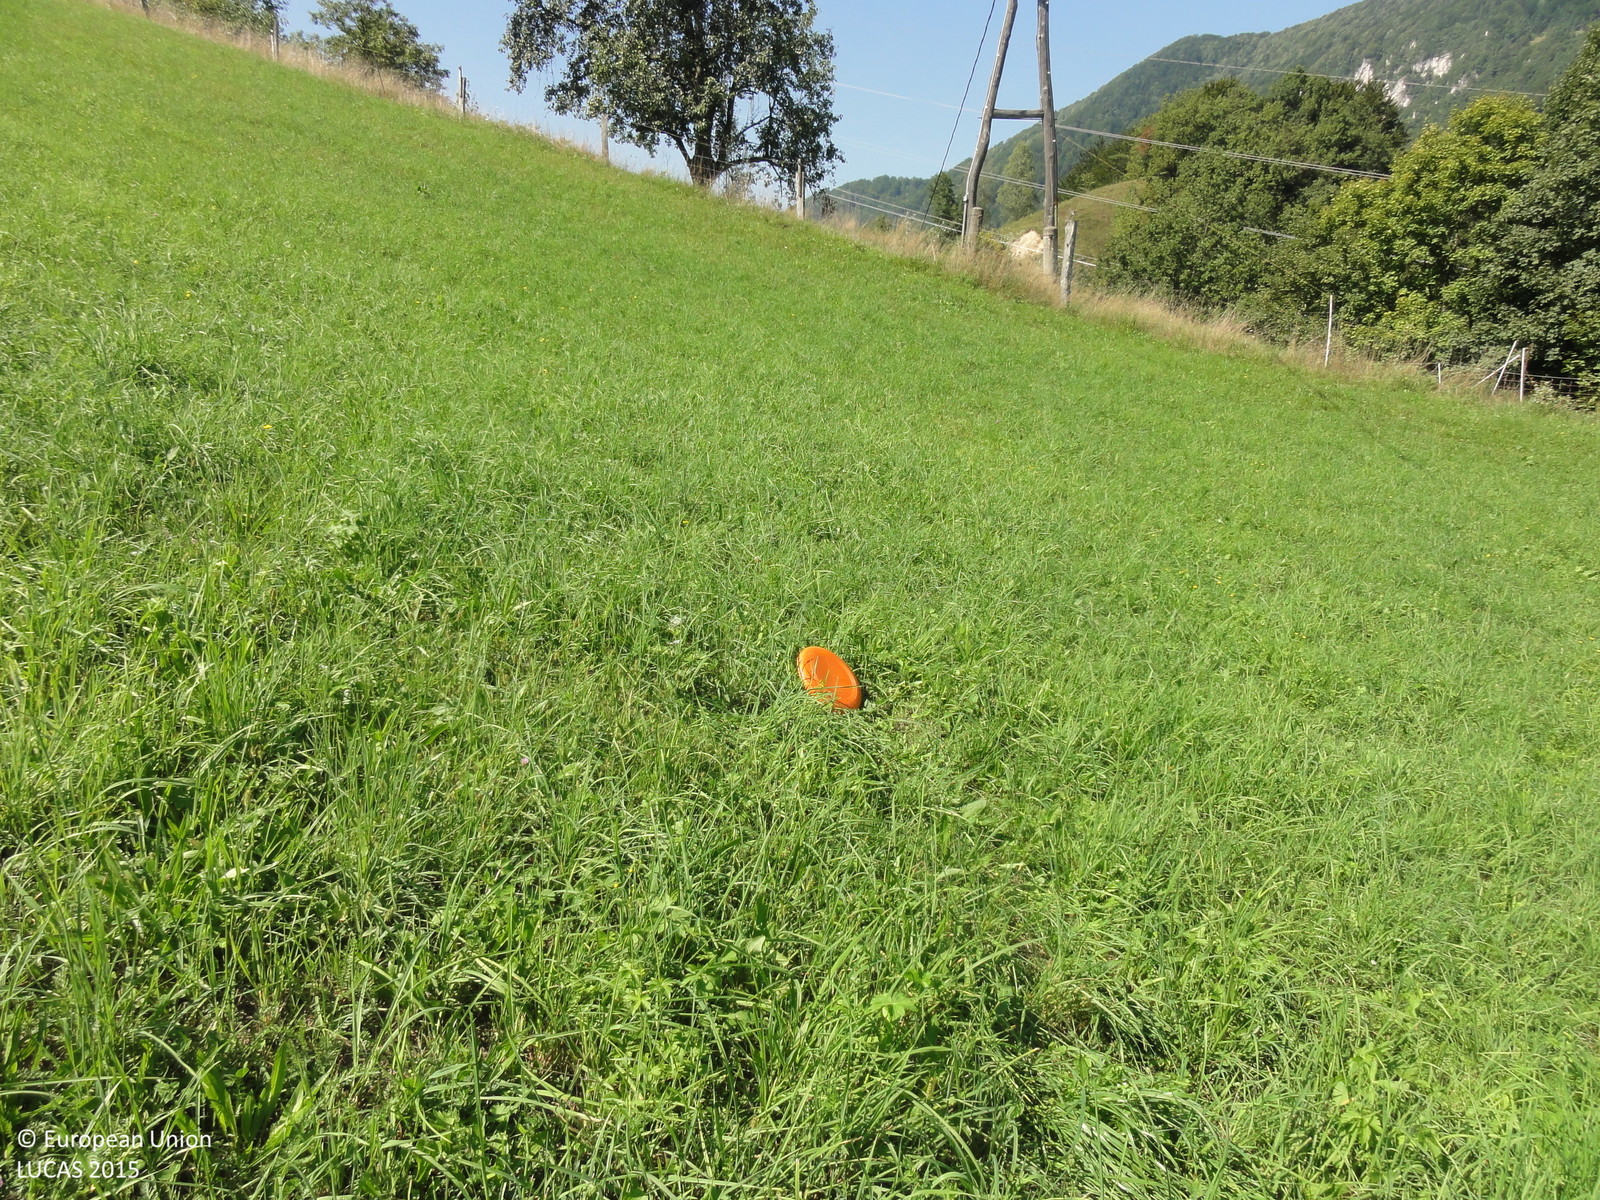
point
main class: Grassland
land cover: Grassland without tree/shrub cover
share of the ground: > 75 %
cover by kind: herbaceous plants 100 %
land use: Agriculture (excluding fallow land and kitchen gardens)
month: August
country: SI
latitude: 46.1017
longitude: 15.1328
